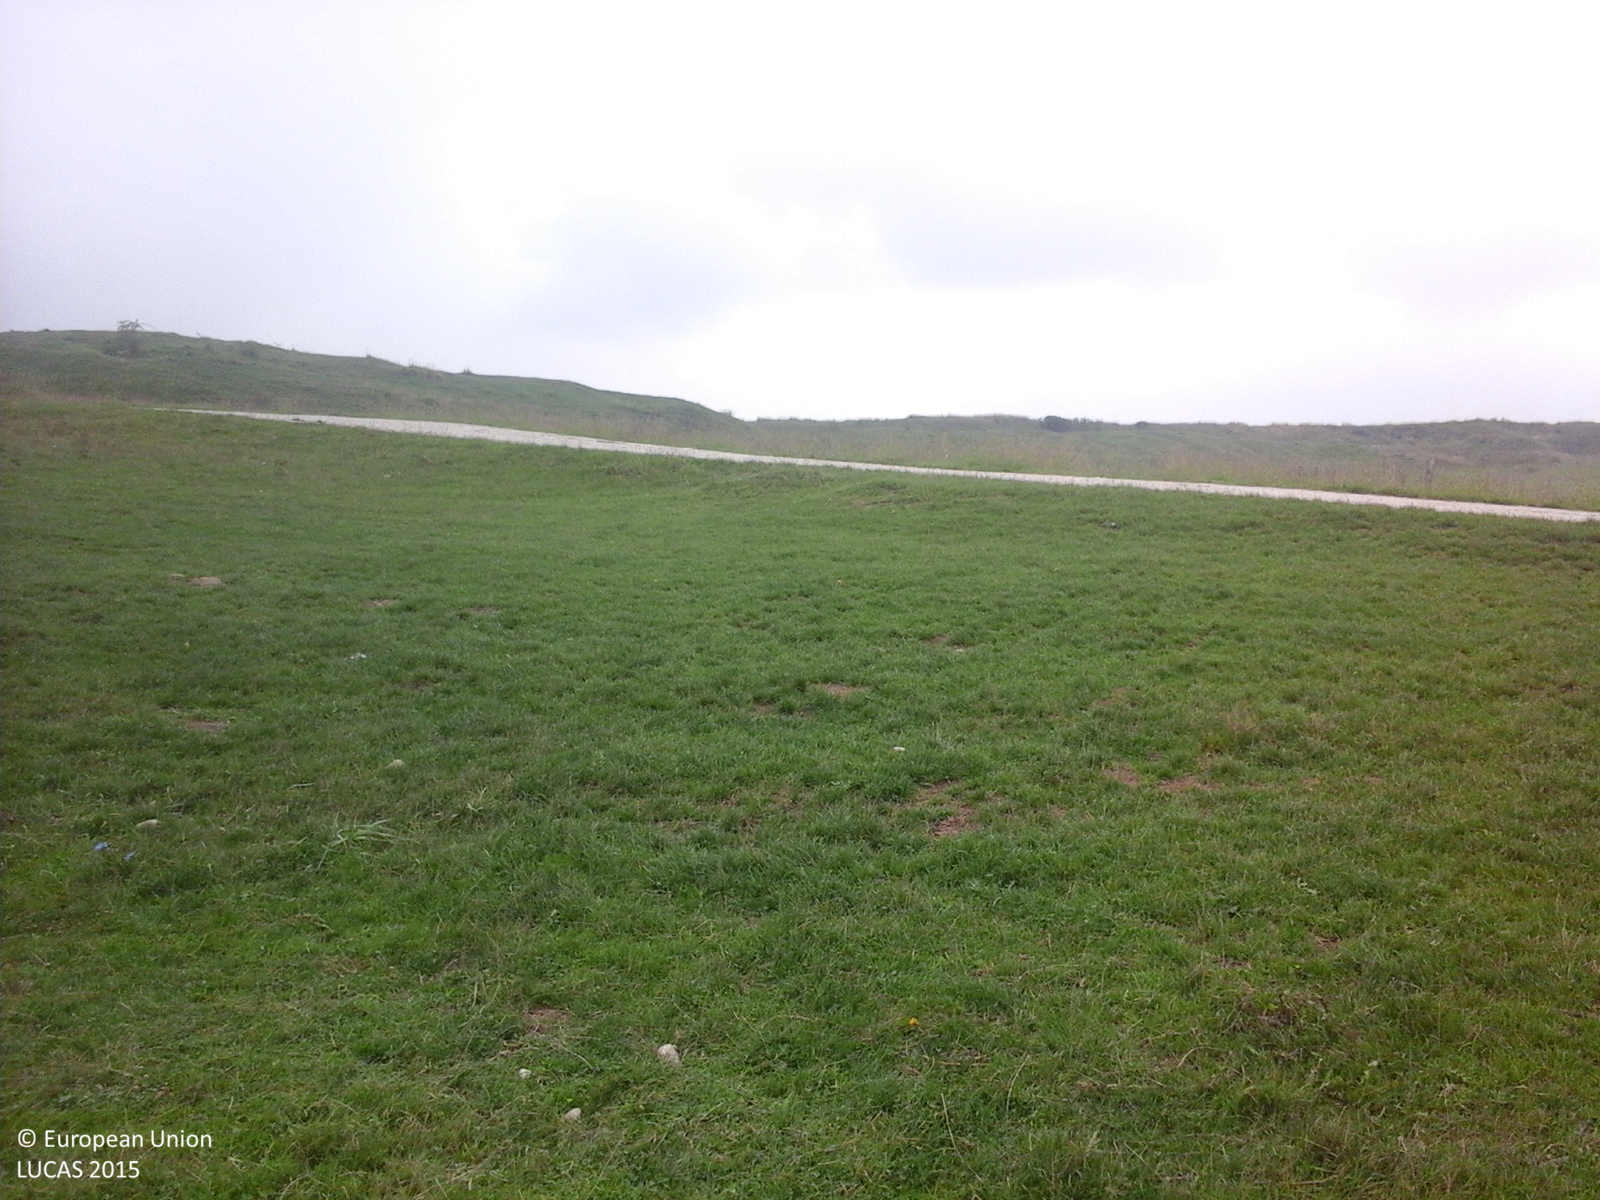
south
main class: Grassland
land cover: Grassland without tree/shrub cover
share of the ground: > 75 %
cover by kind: herbaceous plants 100 %
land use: Agriculture (excluding fallow land and kitchen gardens)
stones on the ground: < 10 %
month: September
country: RO
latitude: 44.9407
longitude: 23.0906
